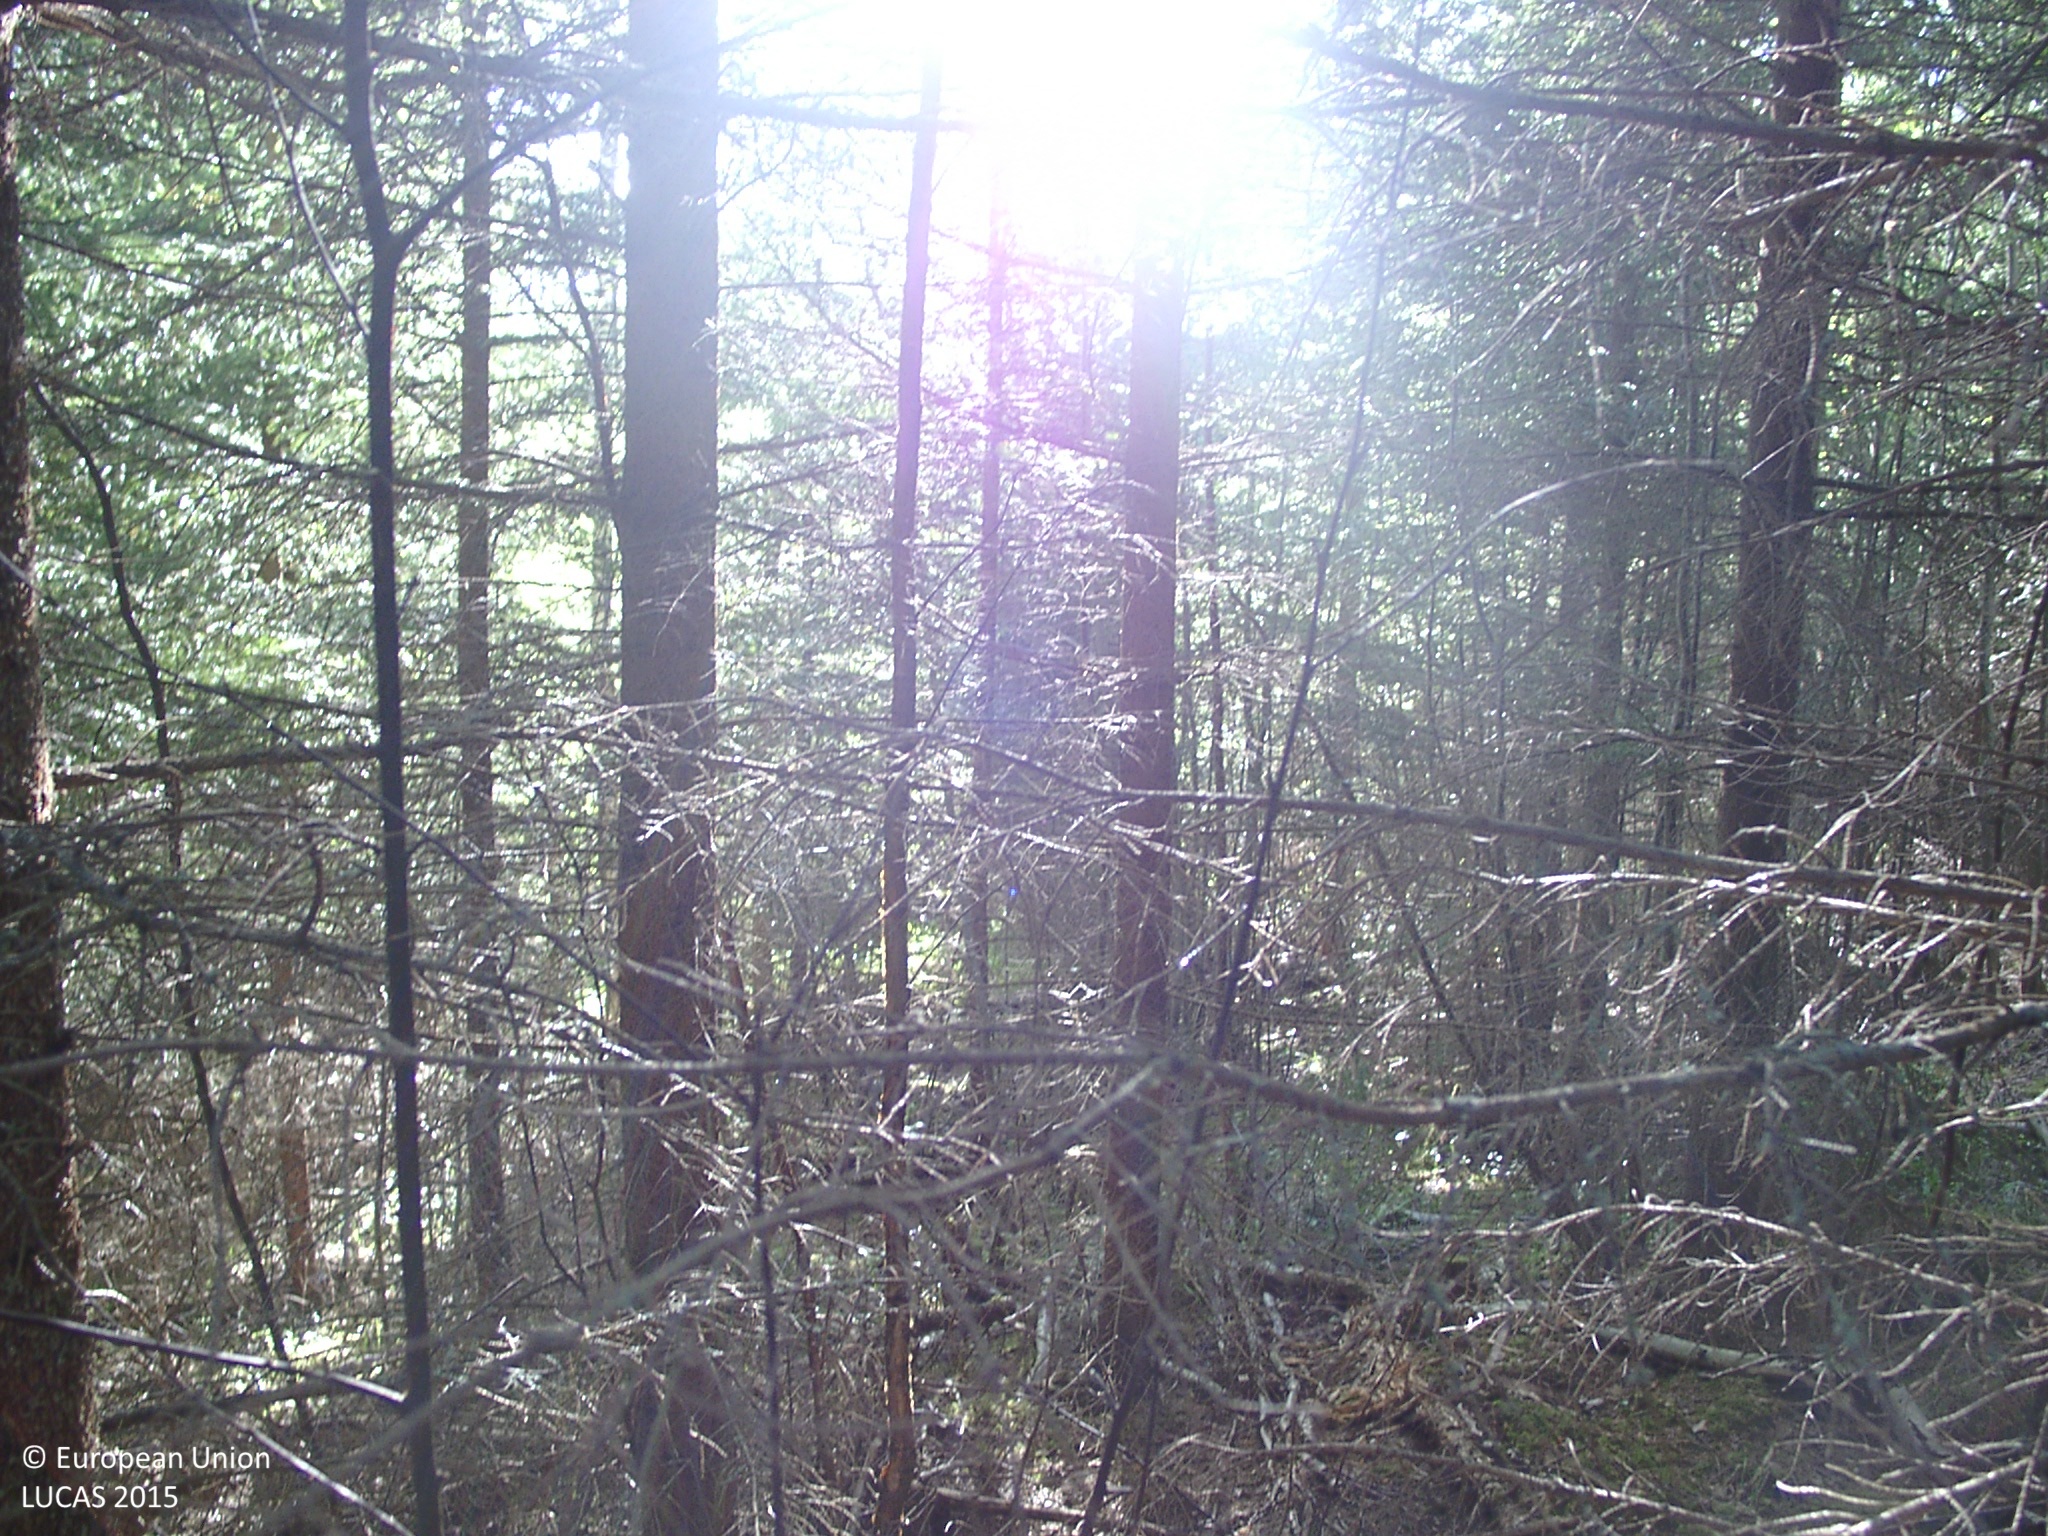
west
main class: Woodland
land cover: Spruce dominated coniferous woodland
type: boreal forest
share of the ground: > 75 %
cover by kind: coniferous forest trees 70 %, broadleaved forest trees 15 %, shrubs 5 %, herbaceous plants 5 %, lichens and mosses 5 %
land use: Forestry
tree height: > 5 m
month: June
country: FI
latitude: 62.1383
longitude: 25.6358
